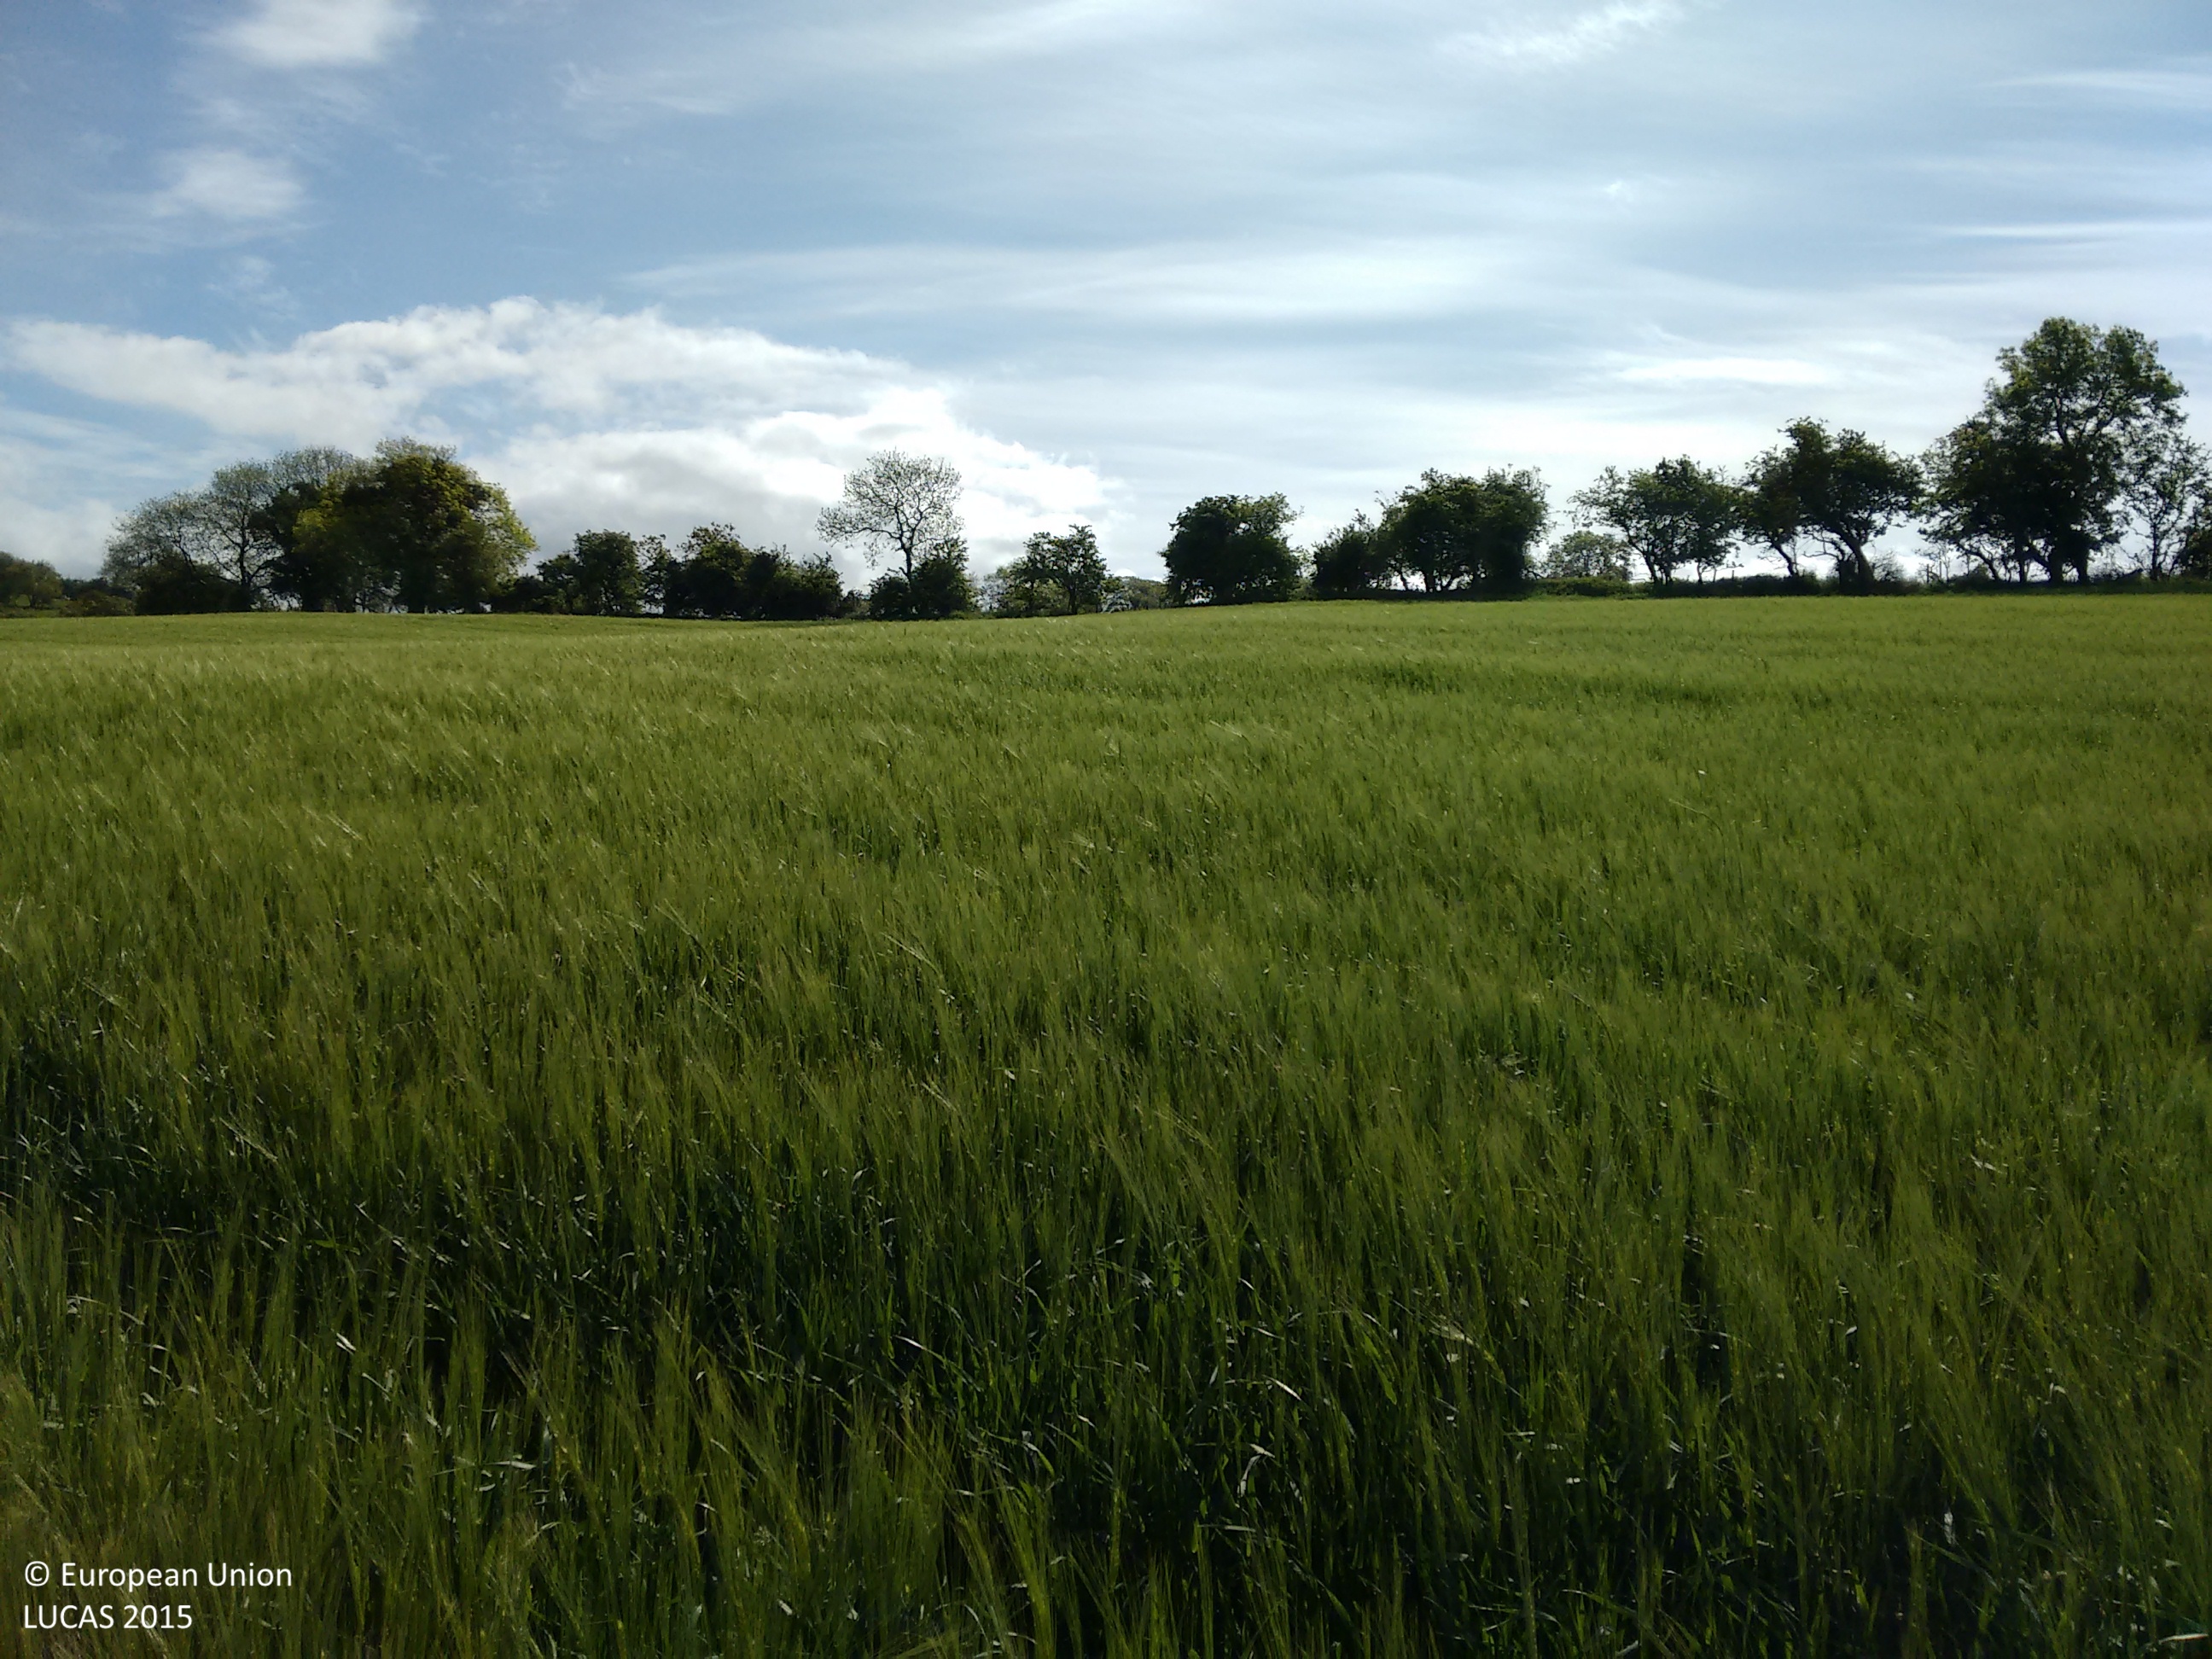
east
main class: Cropland
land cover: Common wheat
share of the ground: > 75 %
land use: Agriculture (excluding fallow land and kitchen gardens)
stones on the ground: < 10 %
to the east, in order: Common wheat; Grass margins; Fences; Grassland without tree/shrub cover
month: June
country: IE
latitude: 53.1852
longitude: -6.5756
